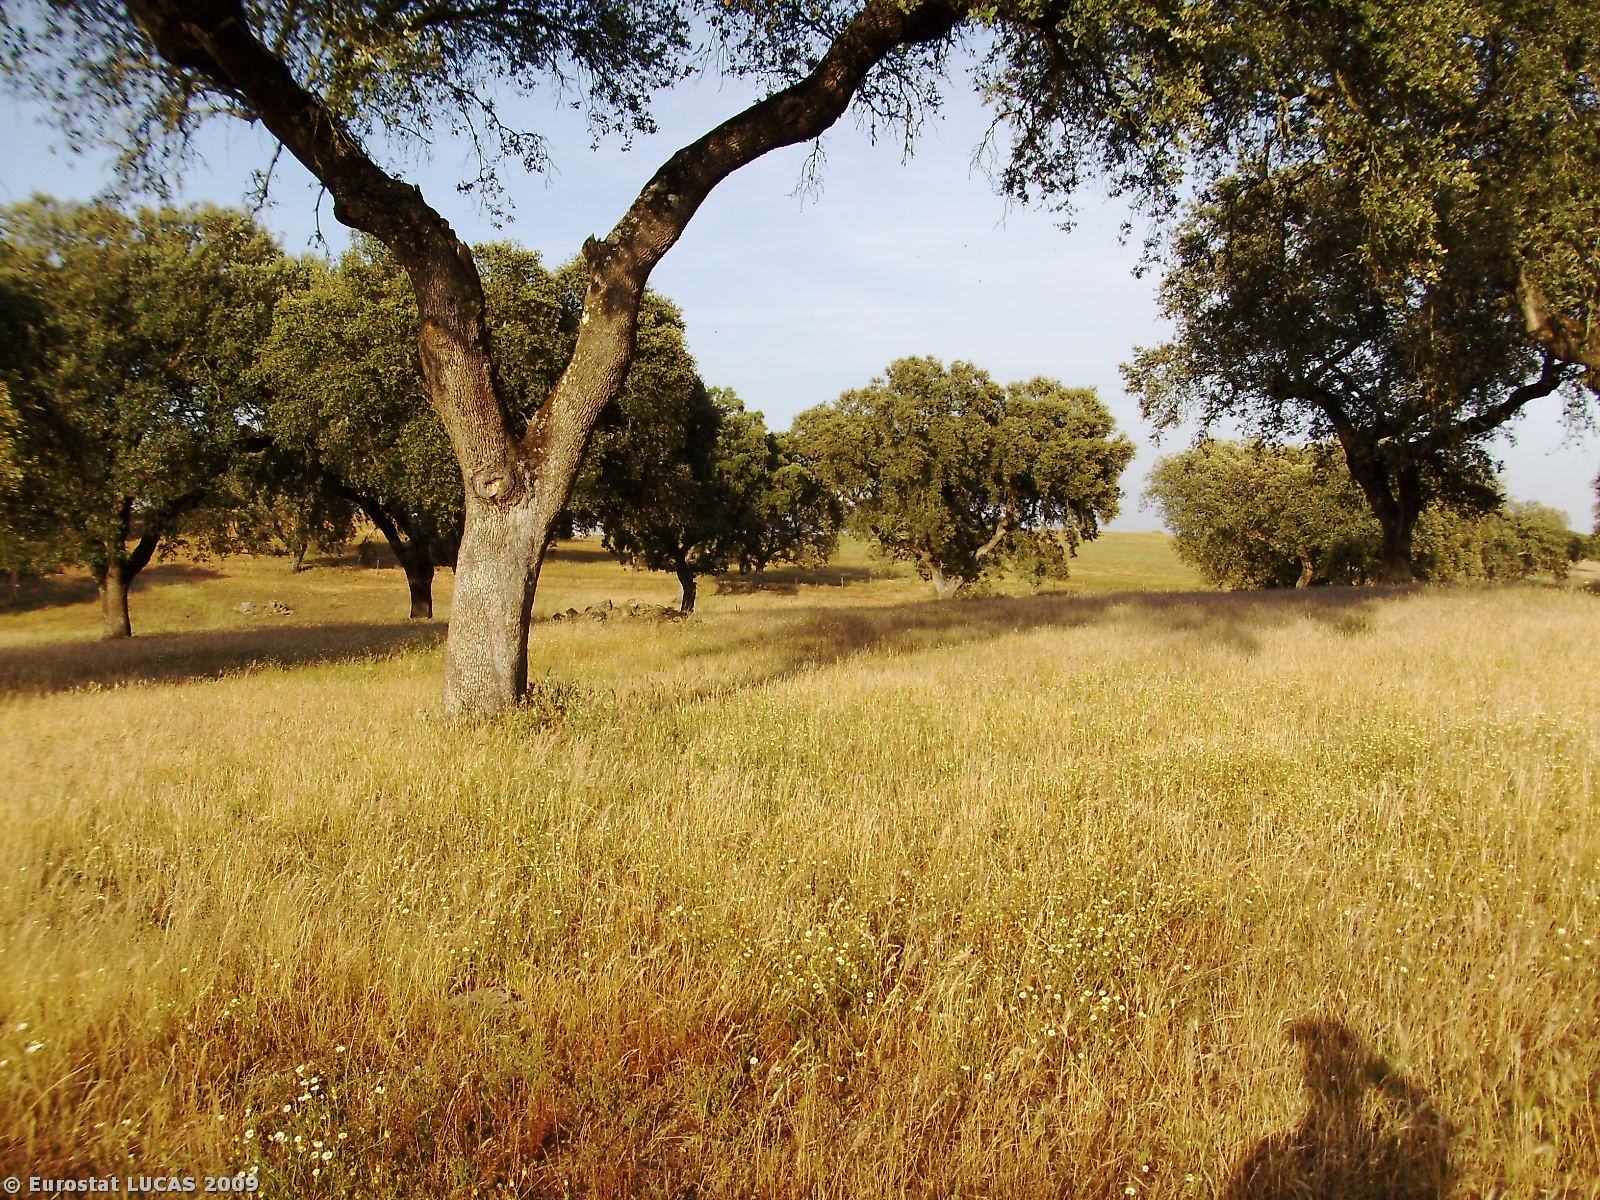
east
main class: Woodland
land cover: Broadleaved woodland
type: broadleaved evergreen forest
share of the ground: 25 - 50 %
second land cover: Grassland with sparse tree/shrub cover
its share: 50 - 75 %
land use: Forestry
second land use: Agriculture (excluding fallow land and kitchen gardens)
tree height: > 5 m
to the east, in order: Broadleaved woodland; Grassland with sparse tree/shrub cover; Broadleaved woodland; Rivers and streams; Grassland with sparse tree/shrub cover; Fences; Grassland with sparse tree/shrub cover
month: June
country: PT
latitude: 39.0316
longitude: -7.3984
